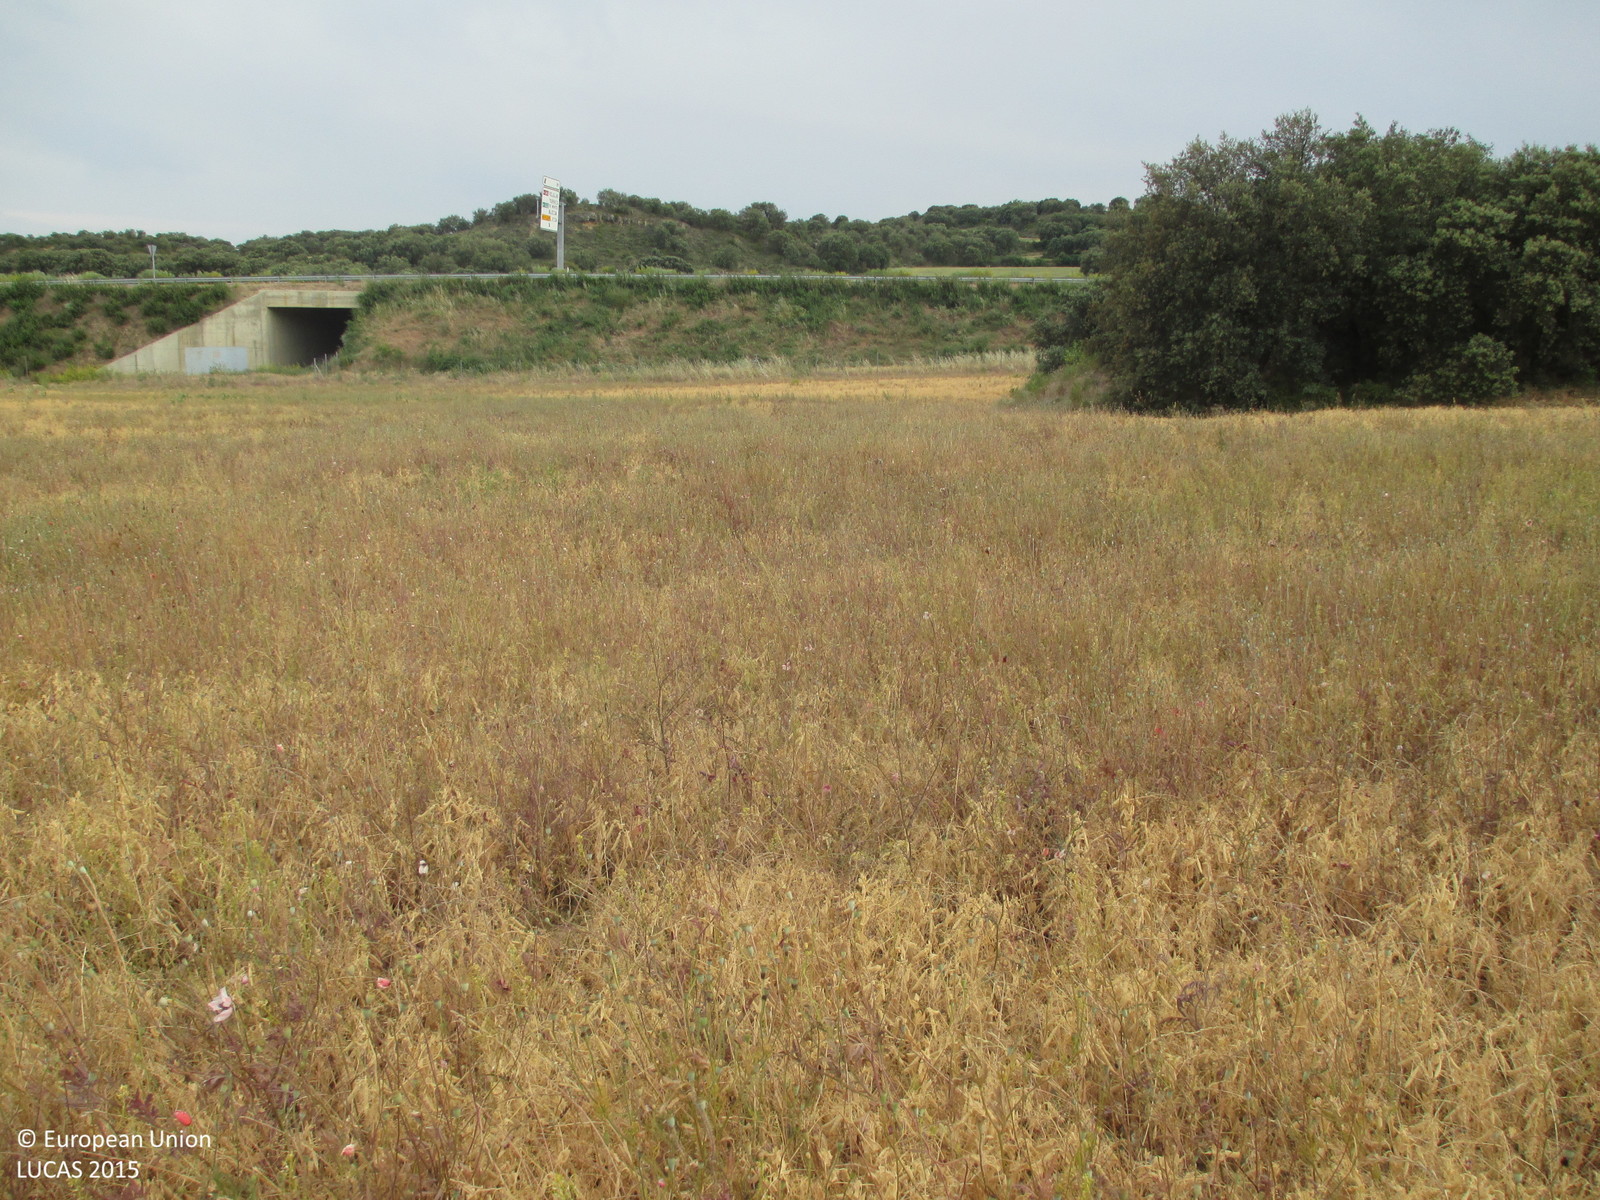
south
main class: Cropland
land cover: Dry pulses
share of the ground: > 75 %
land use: Agriculture (excluding fallow land and kitchen gardens)
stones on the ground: < 10 %
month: May
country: ES
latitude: 42.1154
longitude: -0.2412
